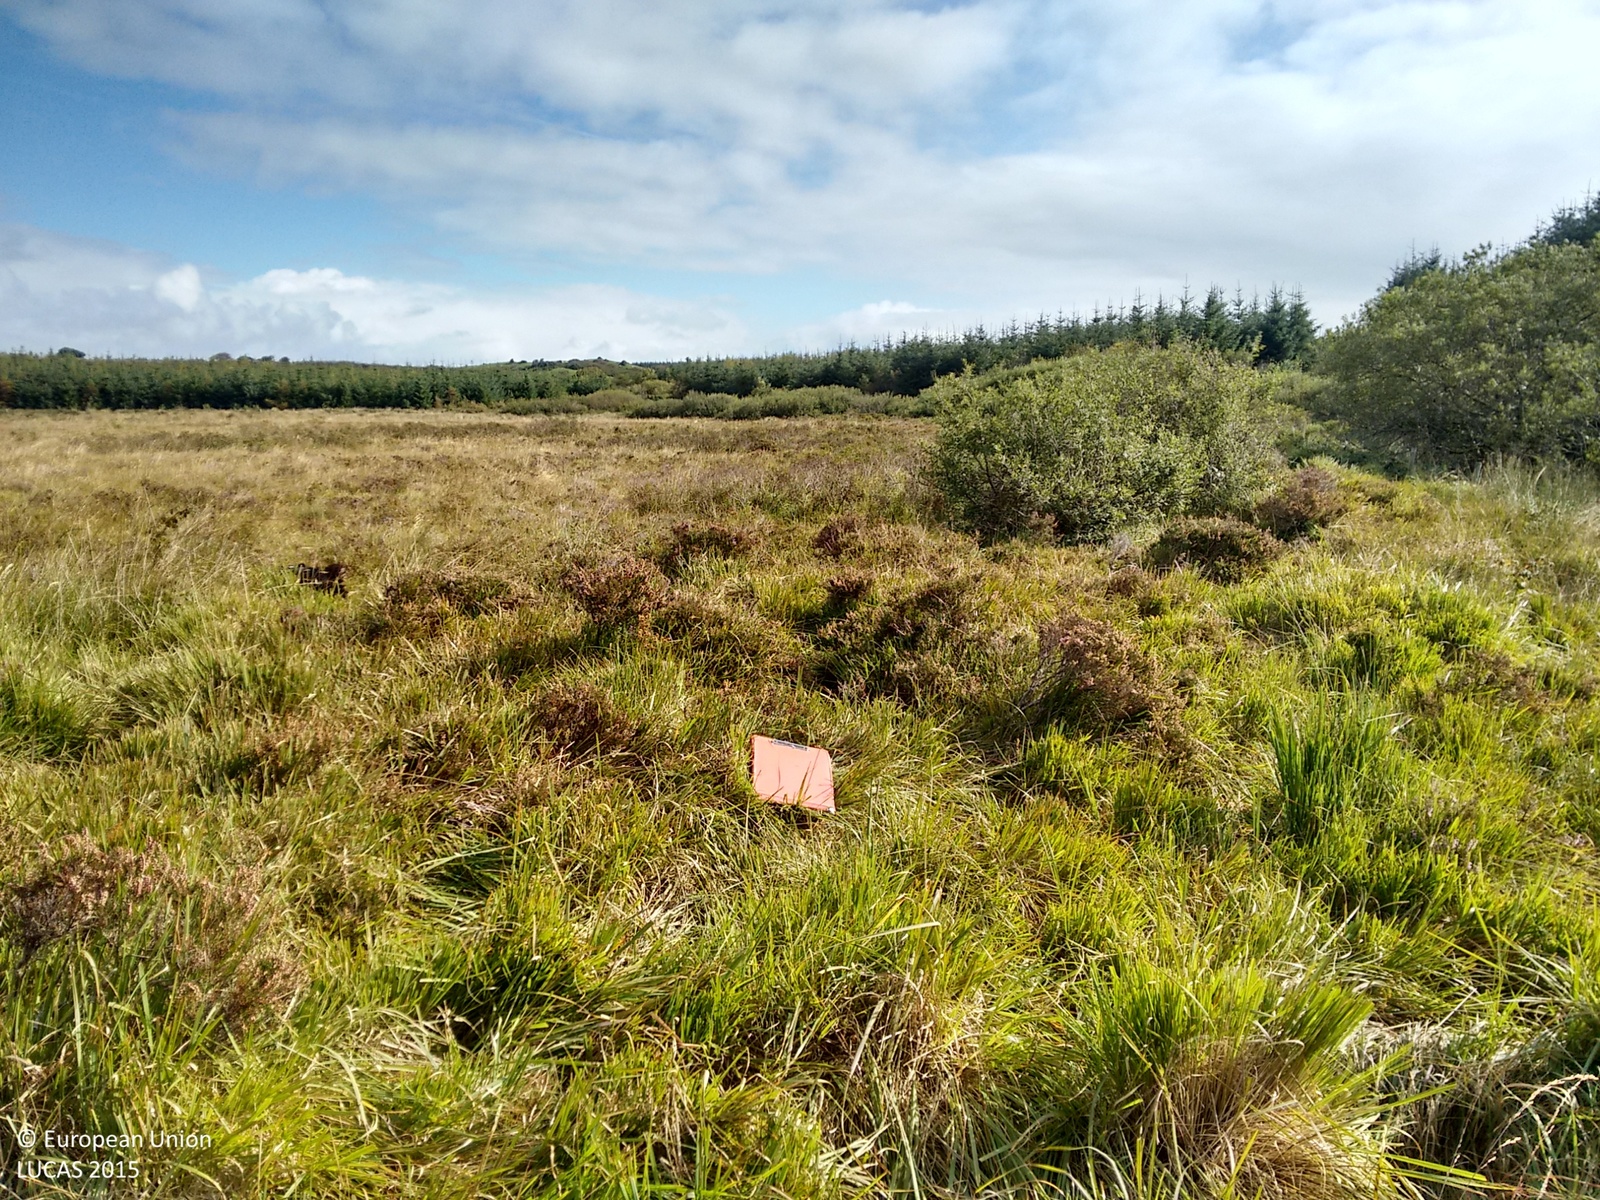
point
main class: Grassland
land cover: Grassland without tree/shrub cover
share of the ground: > 75 %
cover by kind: herbaceous plants 100 %
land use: Agriculture (excluding fallow land and kitchen gardens)
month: September
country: IE
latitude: 52.7568
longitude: -9.3873
